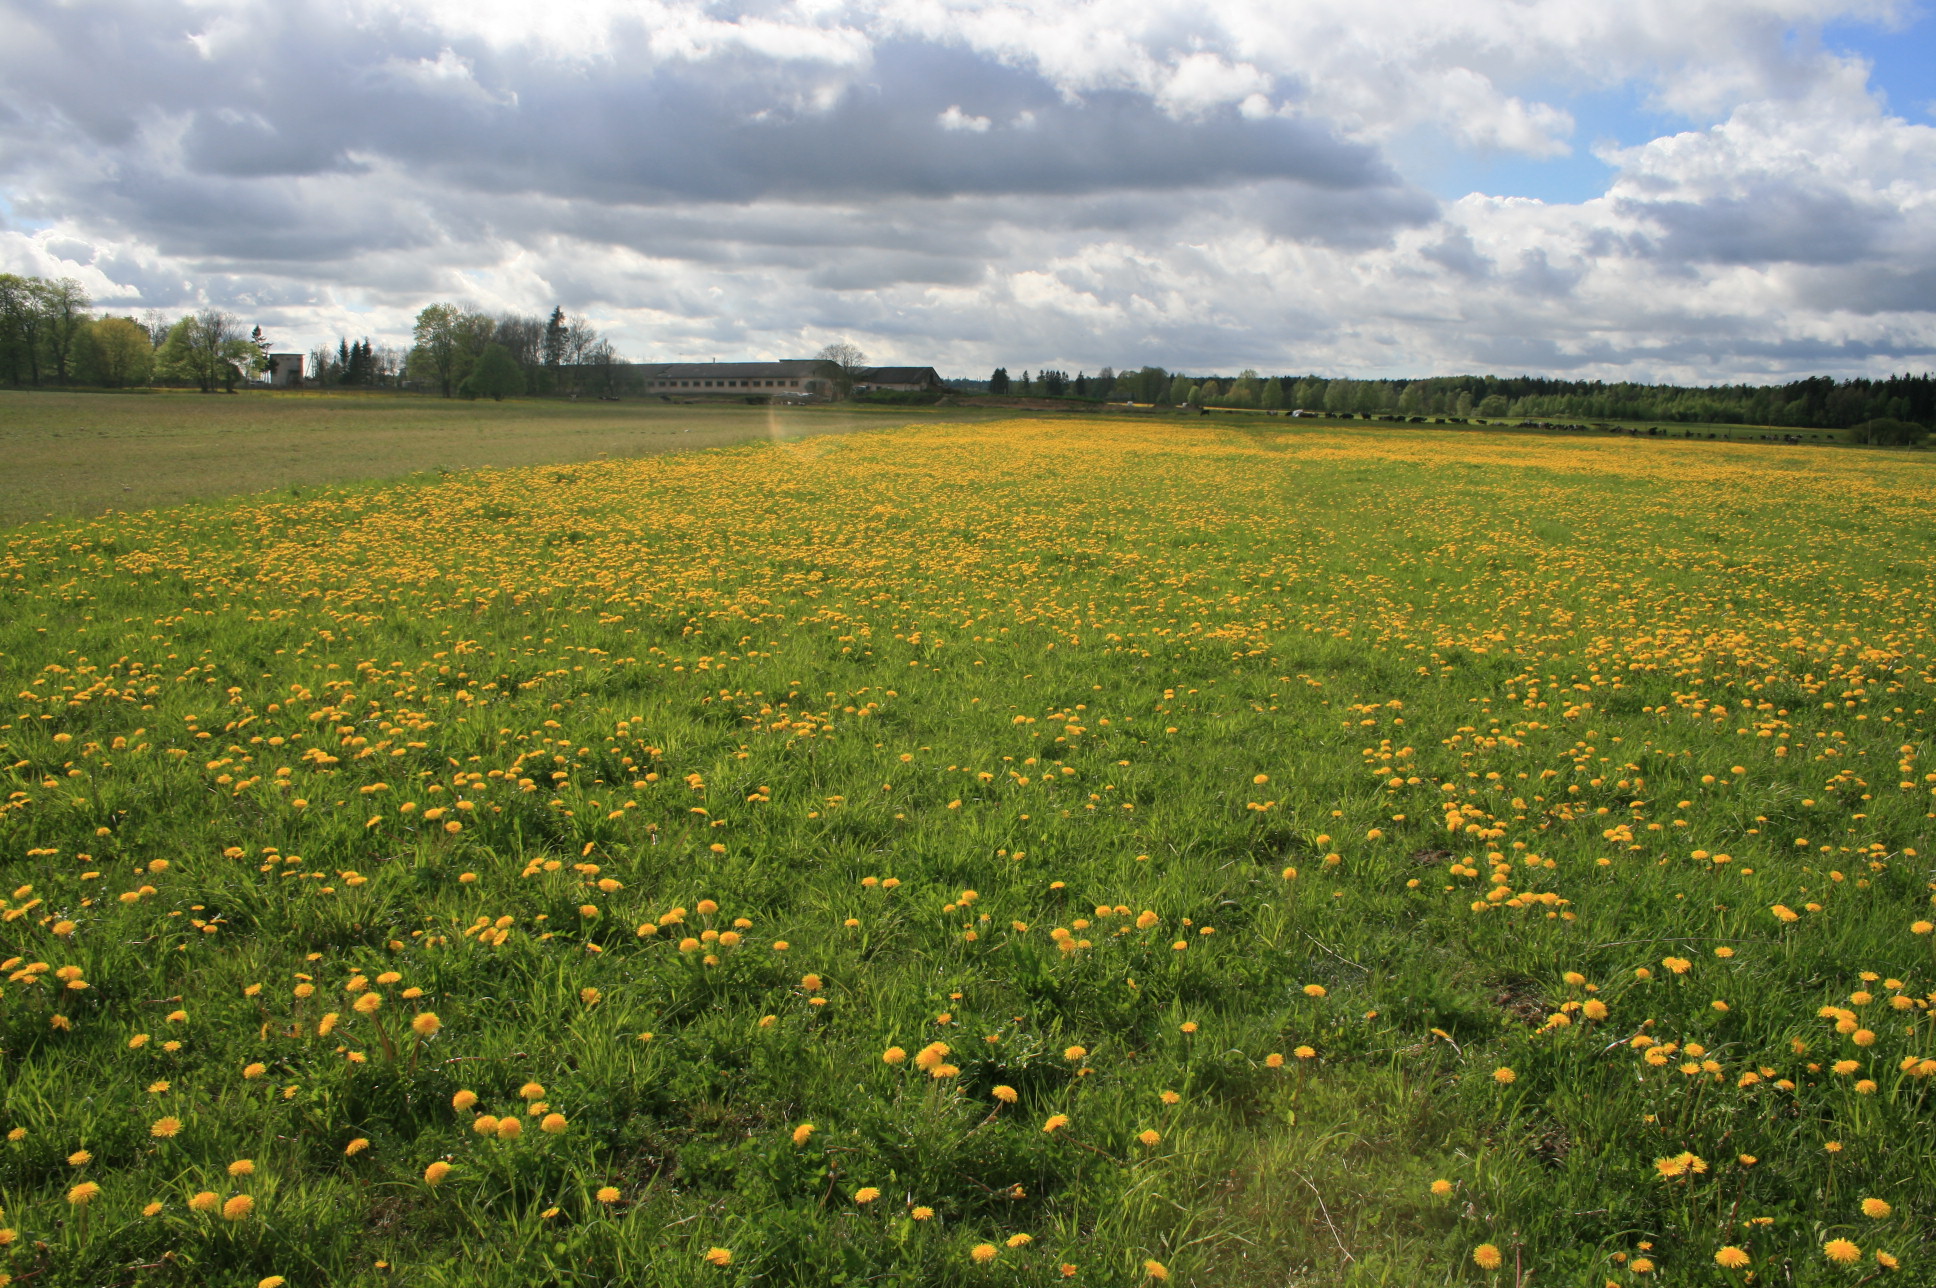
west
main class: Grassland
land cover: Grassland without tree/shrub cover
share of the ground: > 75 %
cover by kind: herbaceous plants 100 %
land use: Agriculture (excluding fallow land and kitchen gardens)
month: May
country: LT
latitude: 56.1960
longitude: 22.0910
